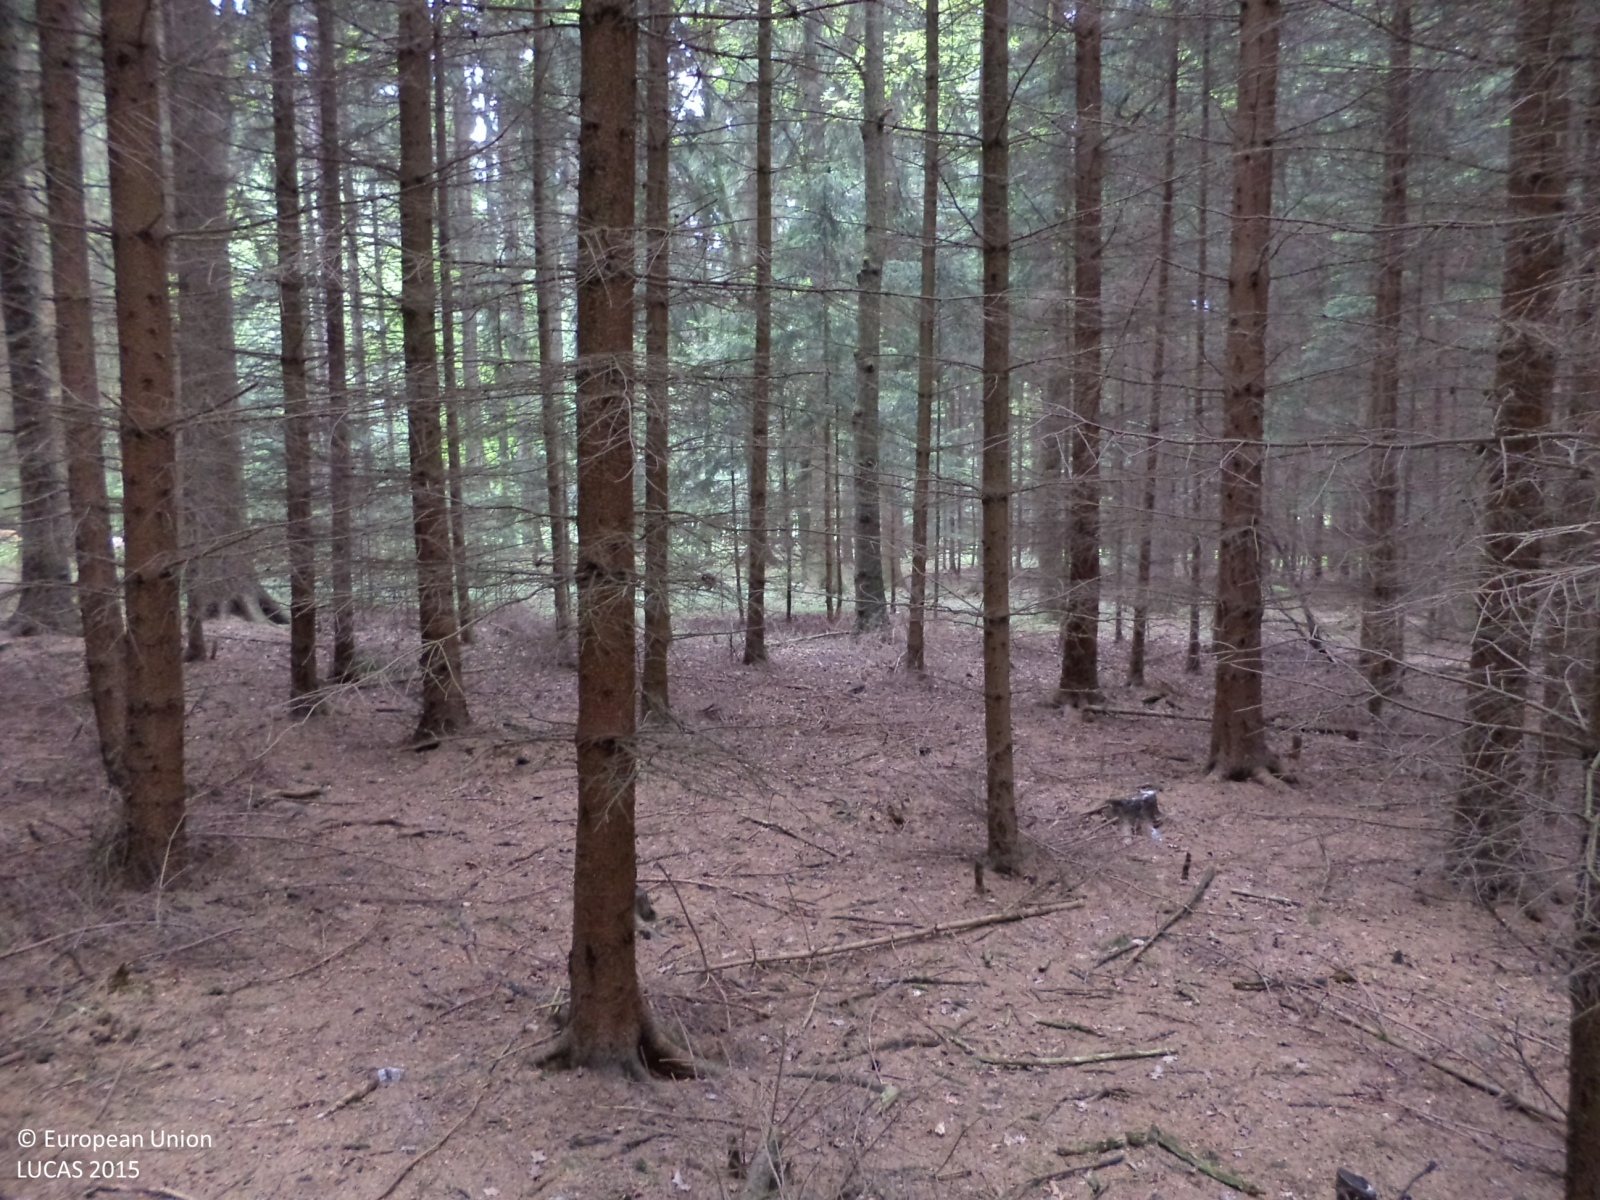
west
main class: Woodland
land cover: Spruce dominated coniferous woodland
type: hemiboreal forest and nemoral coniferous forest and mixed broadleaved-coniferous forest
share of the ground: > 75 %
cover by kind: coniferous forest trees 95 %, lichens and mosses 5 %
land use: Forestry
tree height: > 5 m
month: May
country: CZ
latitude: 49.6215
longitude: 14.6390
